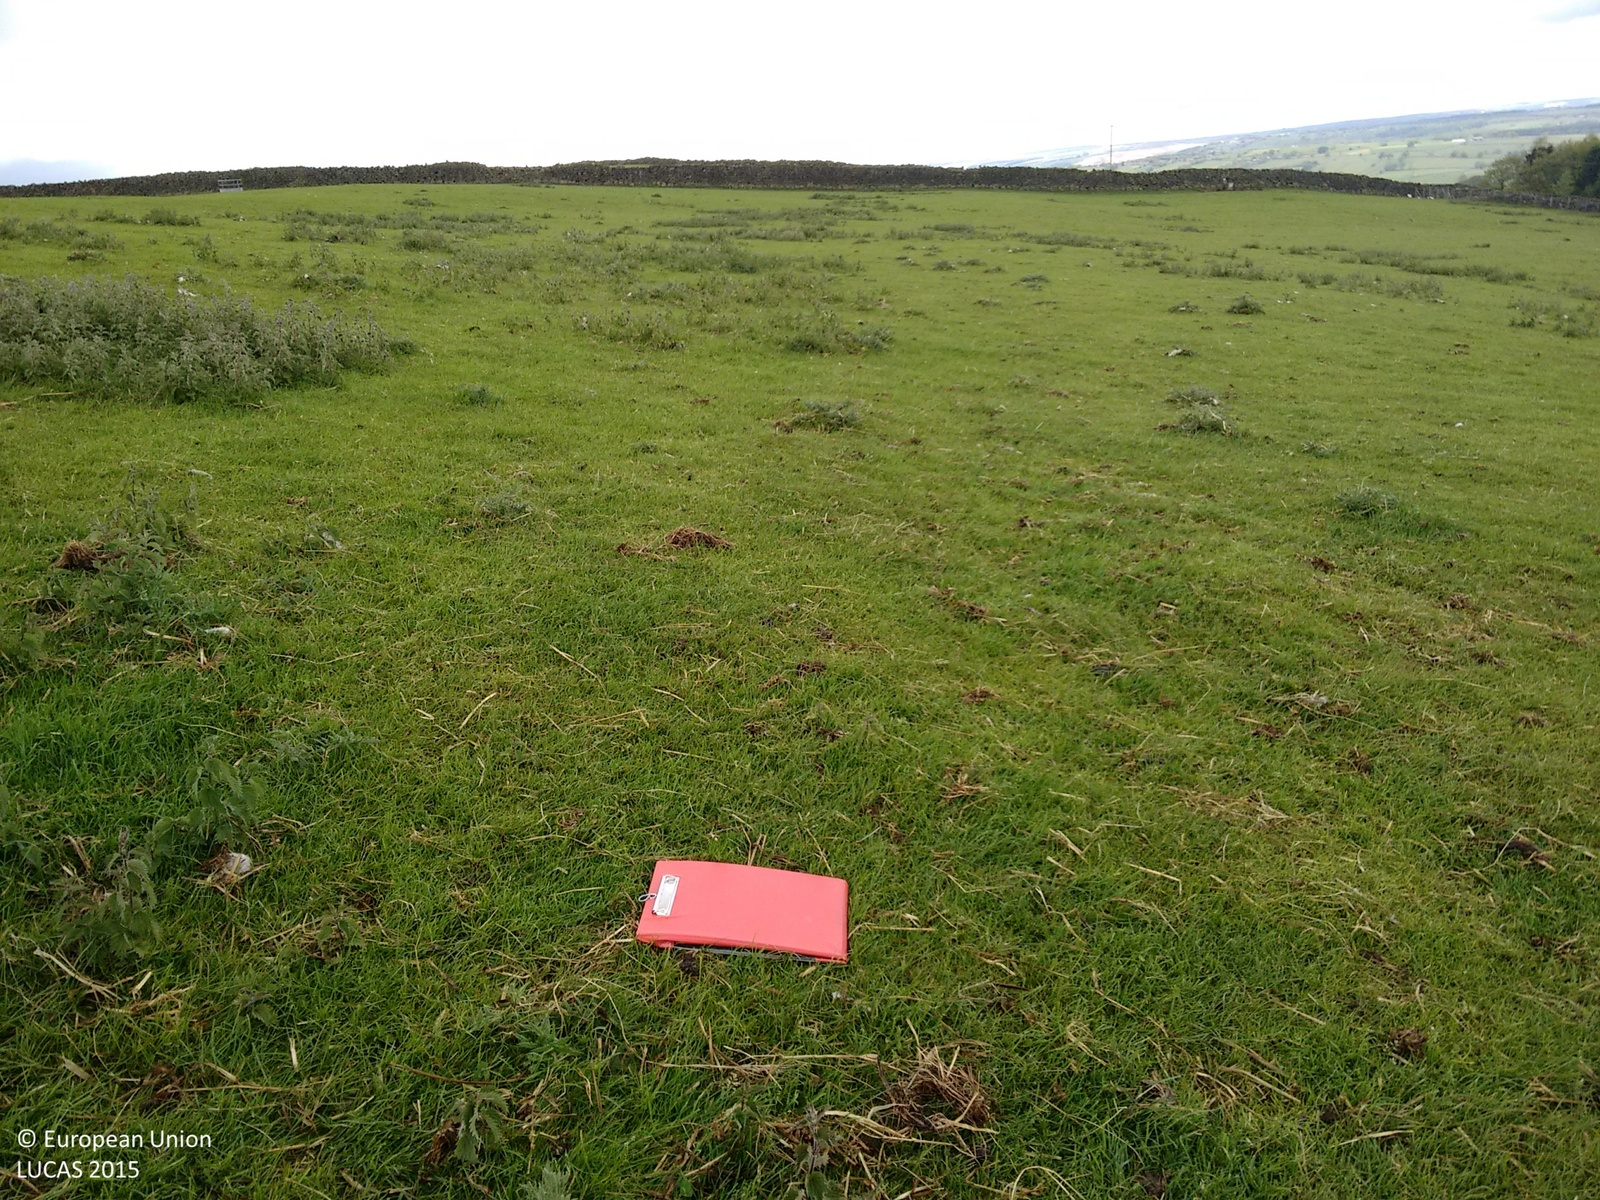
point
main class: Grassland
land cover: Grassland without tree/shrub cover
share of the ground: > 75 %
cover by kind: herbaceous plants 100 %
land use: Agriculture (excluding fallow land and kitchen gardens)
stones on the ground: < 10 %
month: May
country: GB
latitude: 53.9406
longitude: -1.7064
